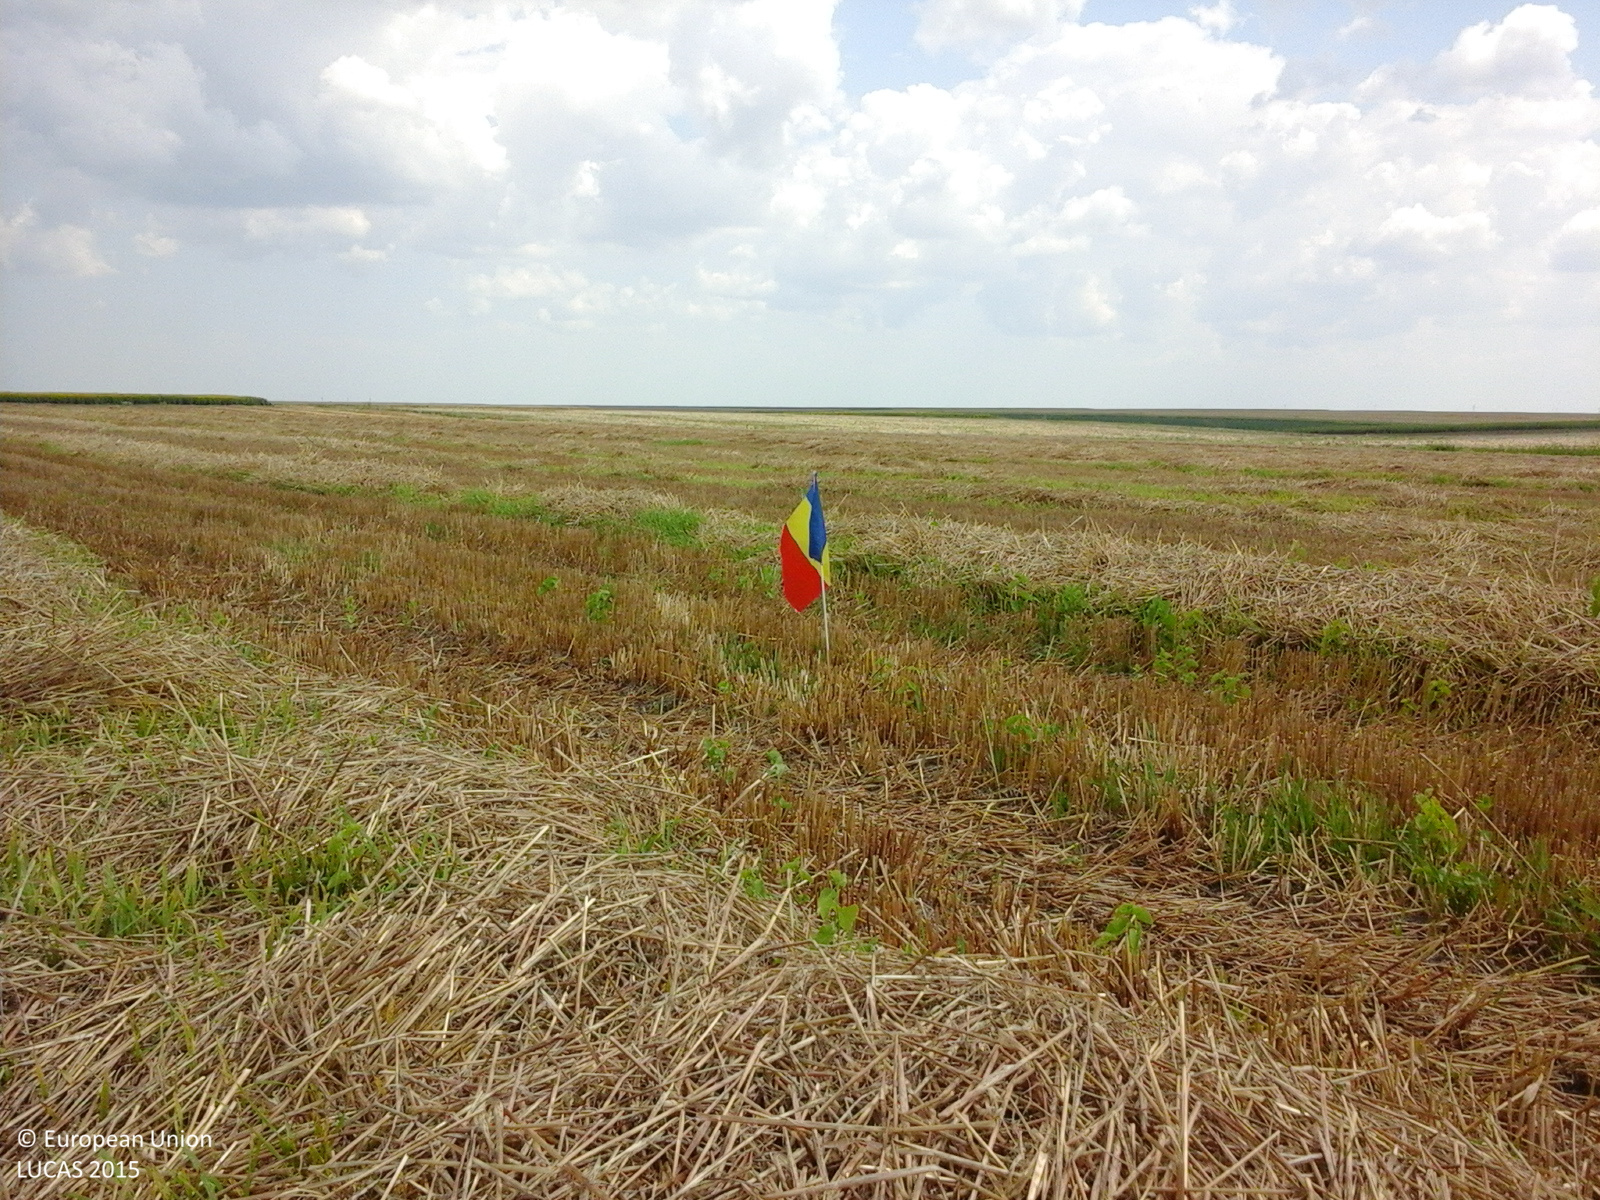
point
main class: Cropland
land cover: Common wheat
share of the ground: < 10 %
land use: Agriculture (excluding fallow land and kitchen gardens)
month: July
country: RO
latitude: 43.9654
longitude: 25.5041
